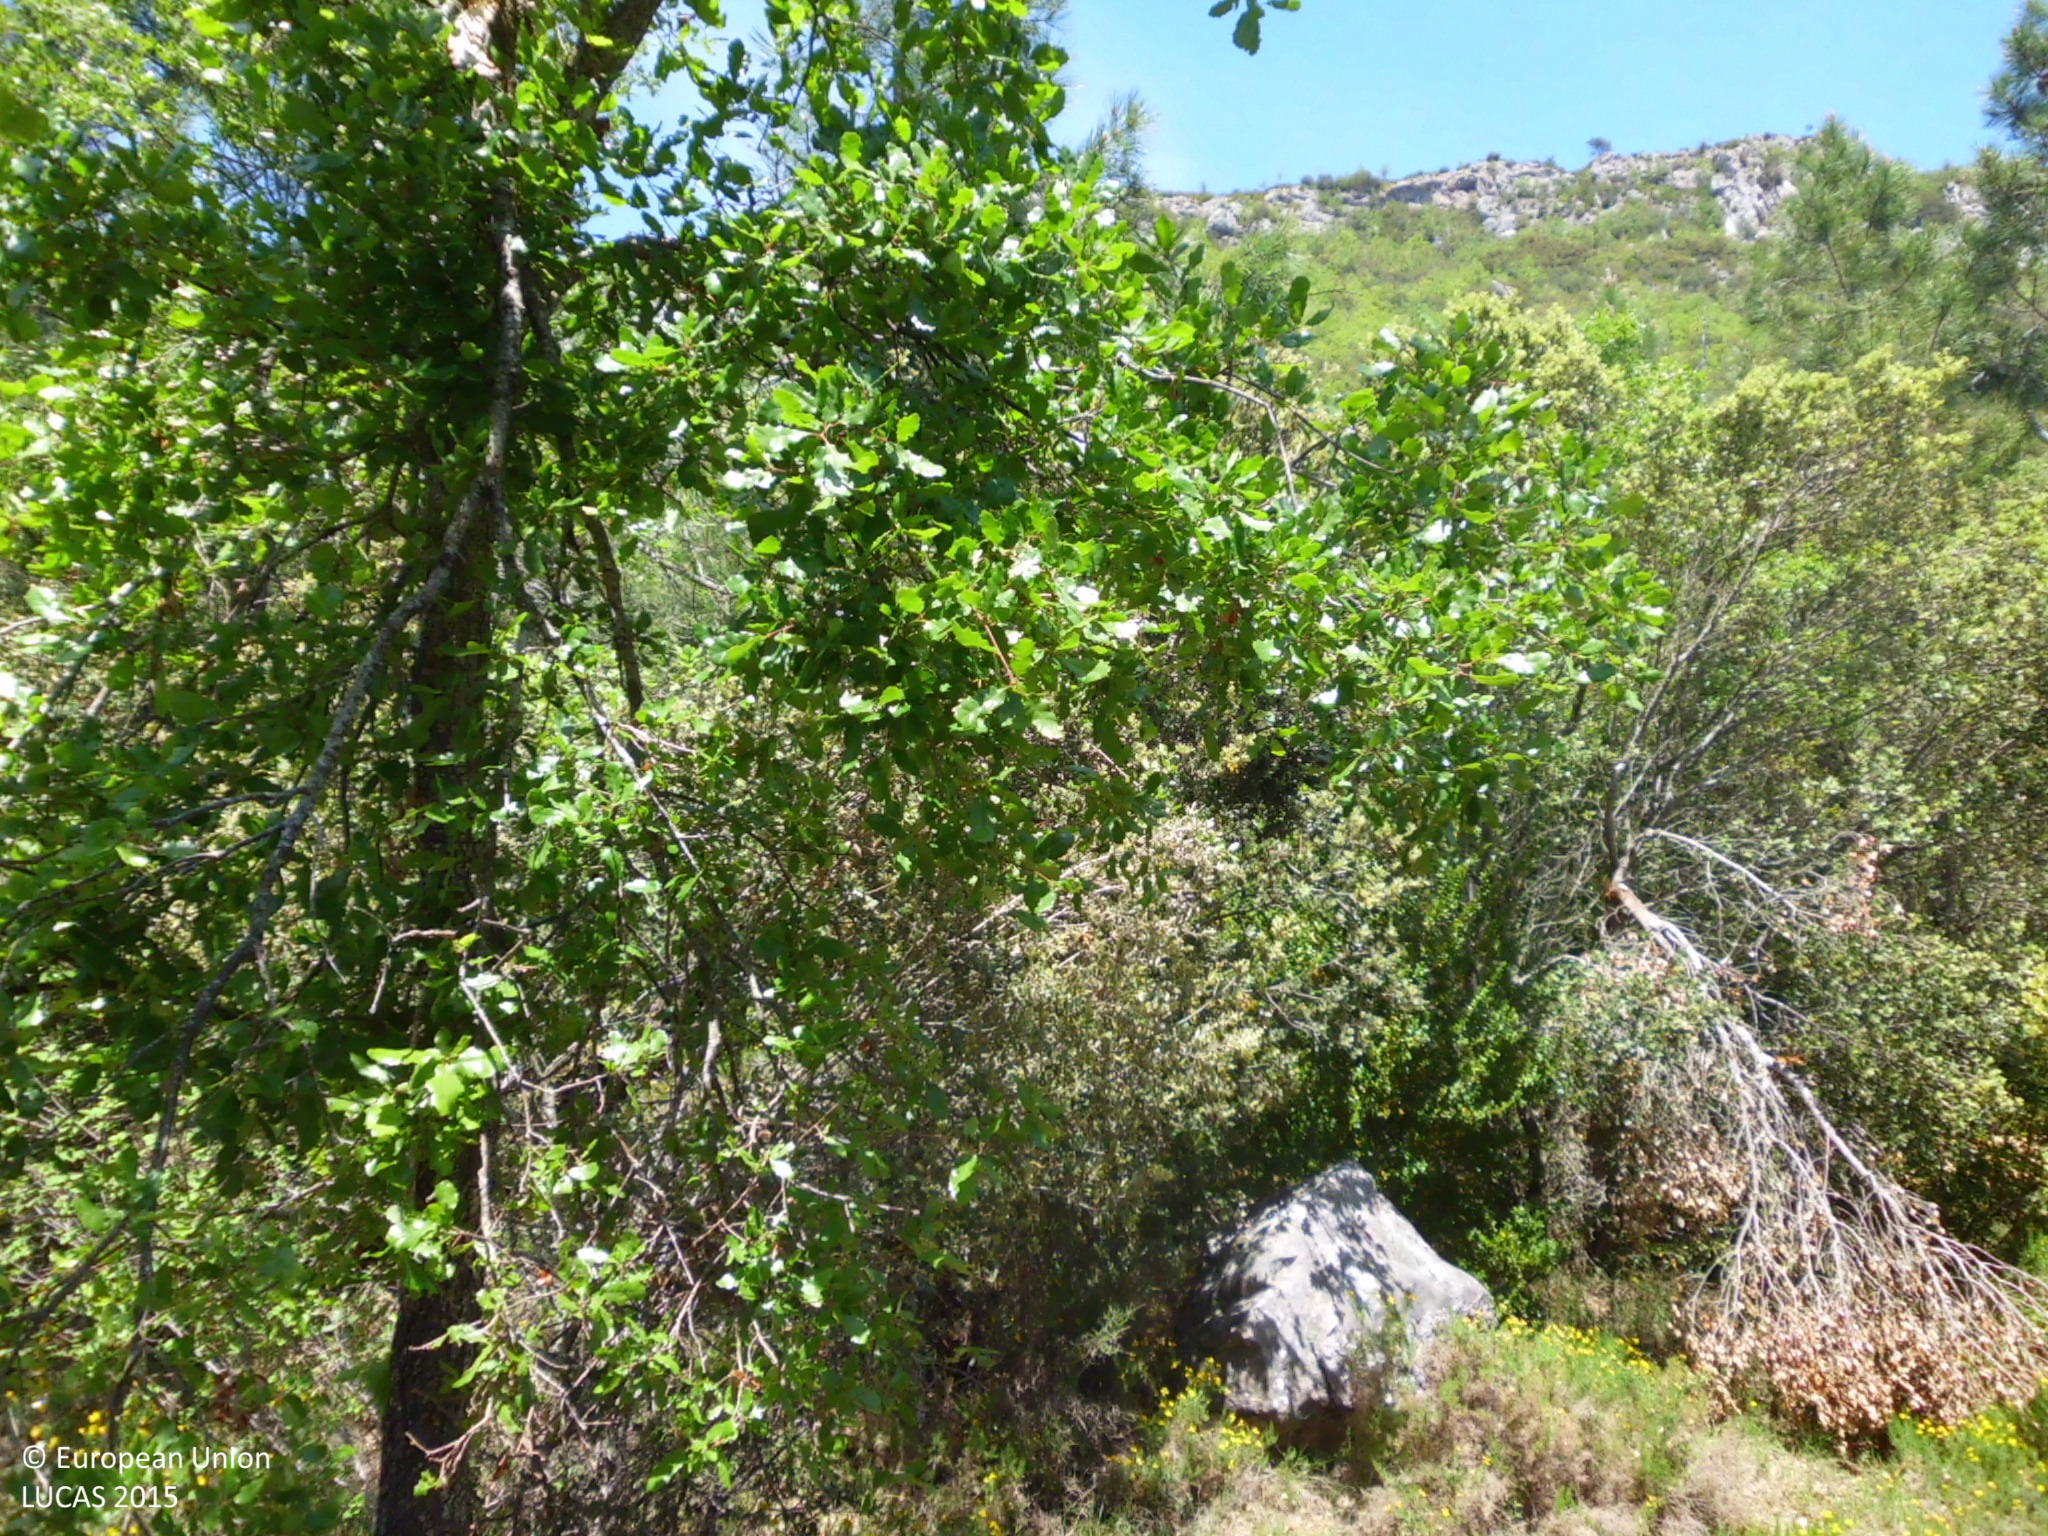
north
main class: Woodland
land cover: Pine dominated coniferous woodland
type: coniferous forest of the mediterranean region
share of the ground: > 75 %
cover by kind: coniferous forest trees 65 %, broadleaved forest trees 15 %, shrubs 10 %, herbaceous plants 10 %
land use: Semi-natural and natural areas not in use
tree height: > 5 m
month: May
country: ES
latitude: 42.7558
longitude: -3.4650
